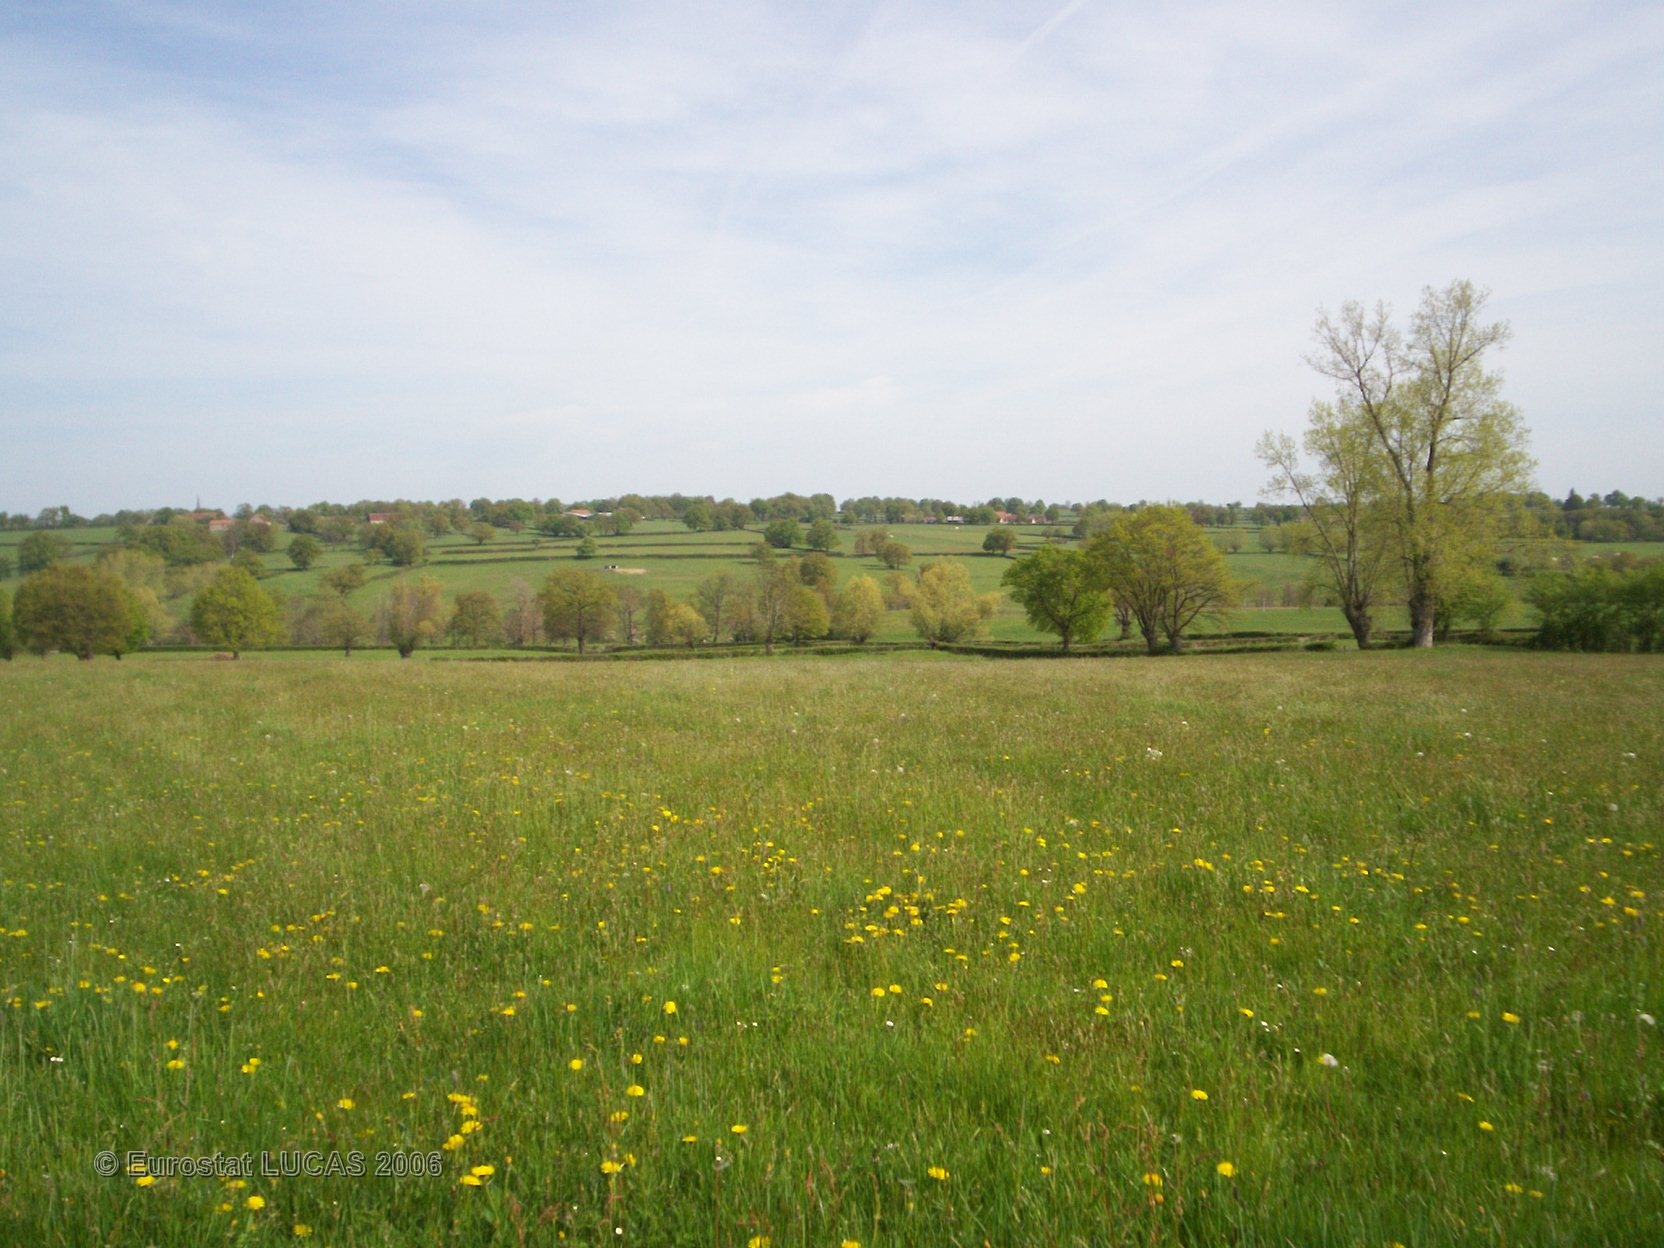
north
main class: Grassland
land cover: Grassland without tree/shrub cover
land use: Agriculture (excluding fallow land and kitchen gardens)
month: May
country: FR
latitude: 46.3321
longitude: 3.1783
